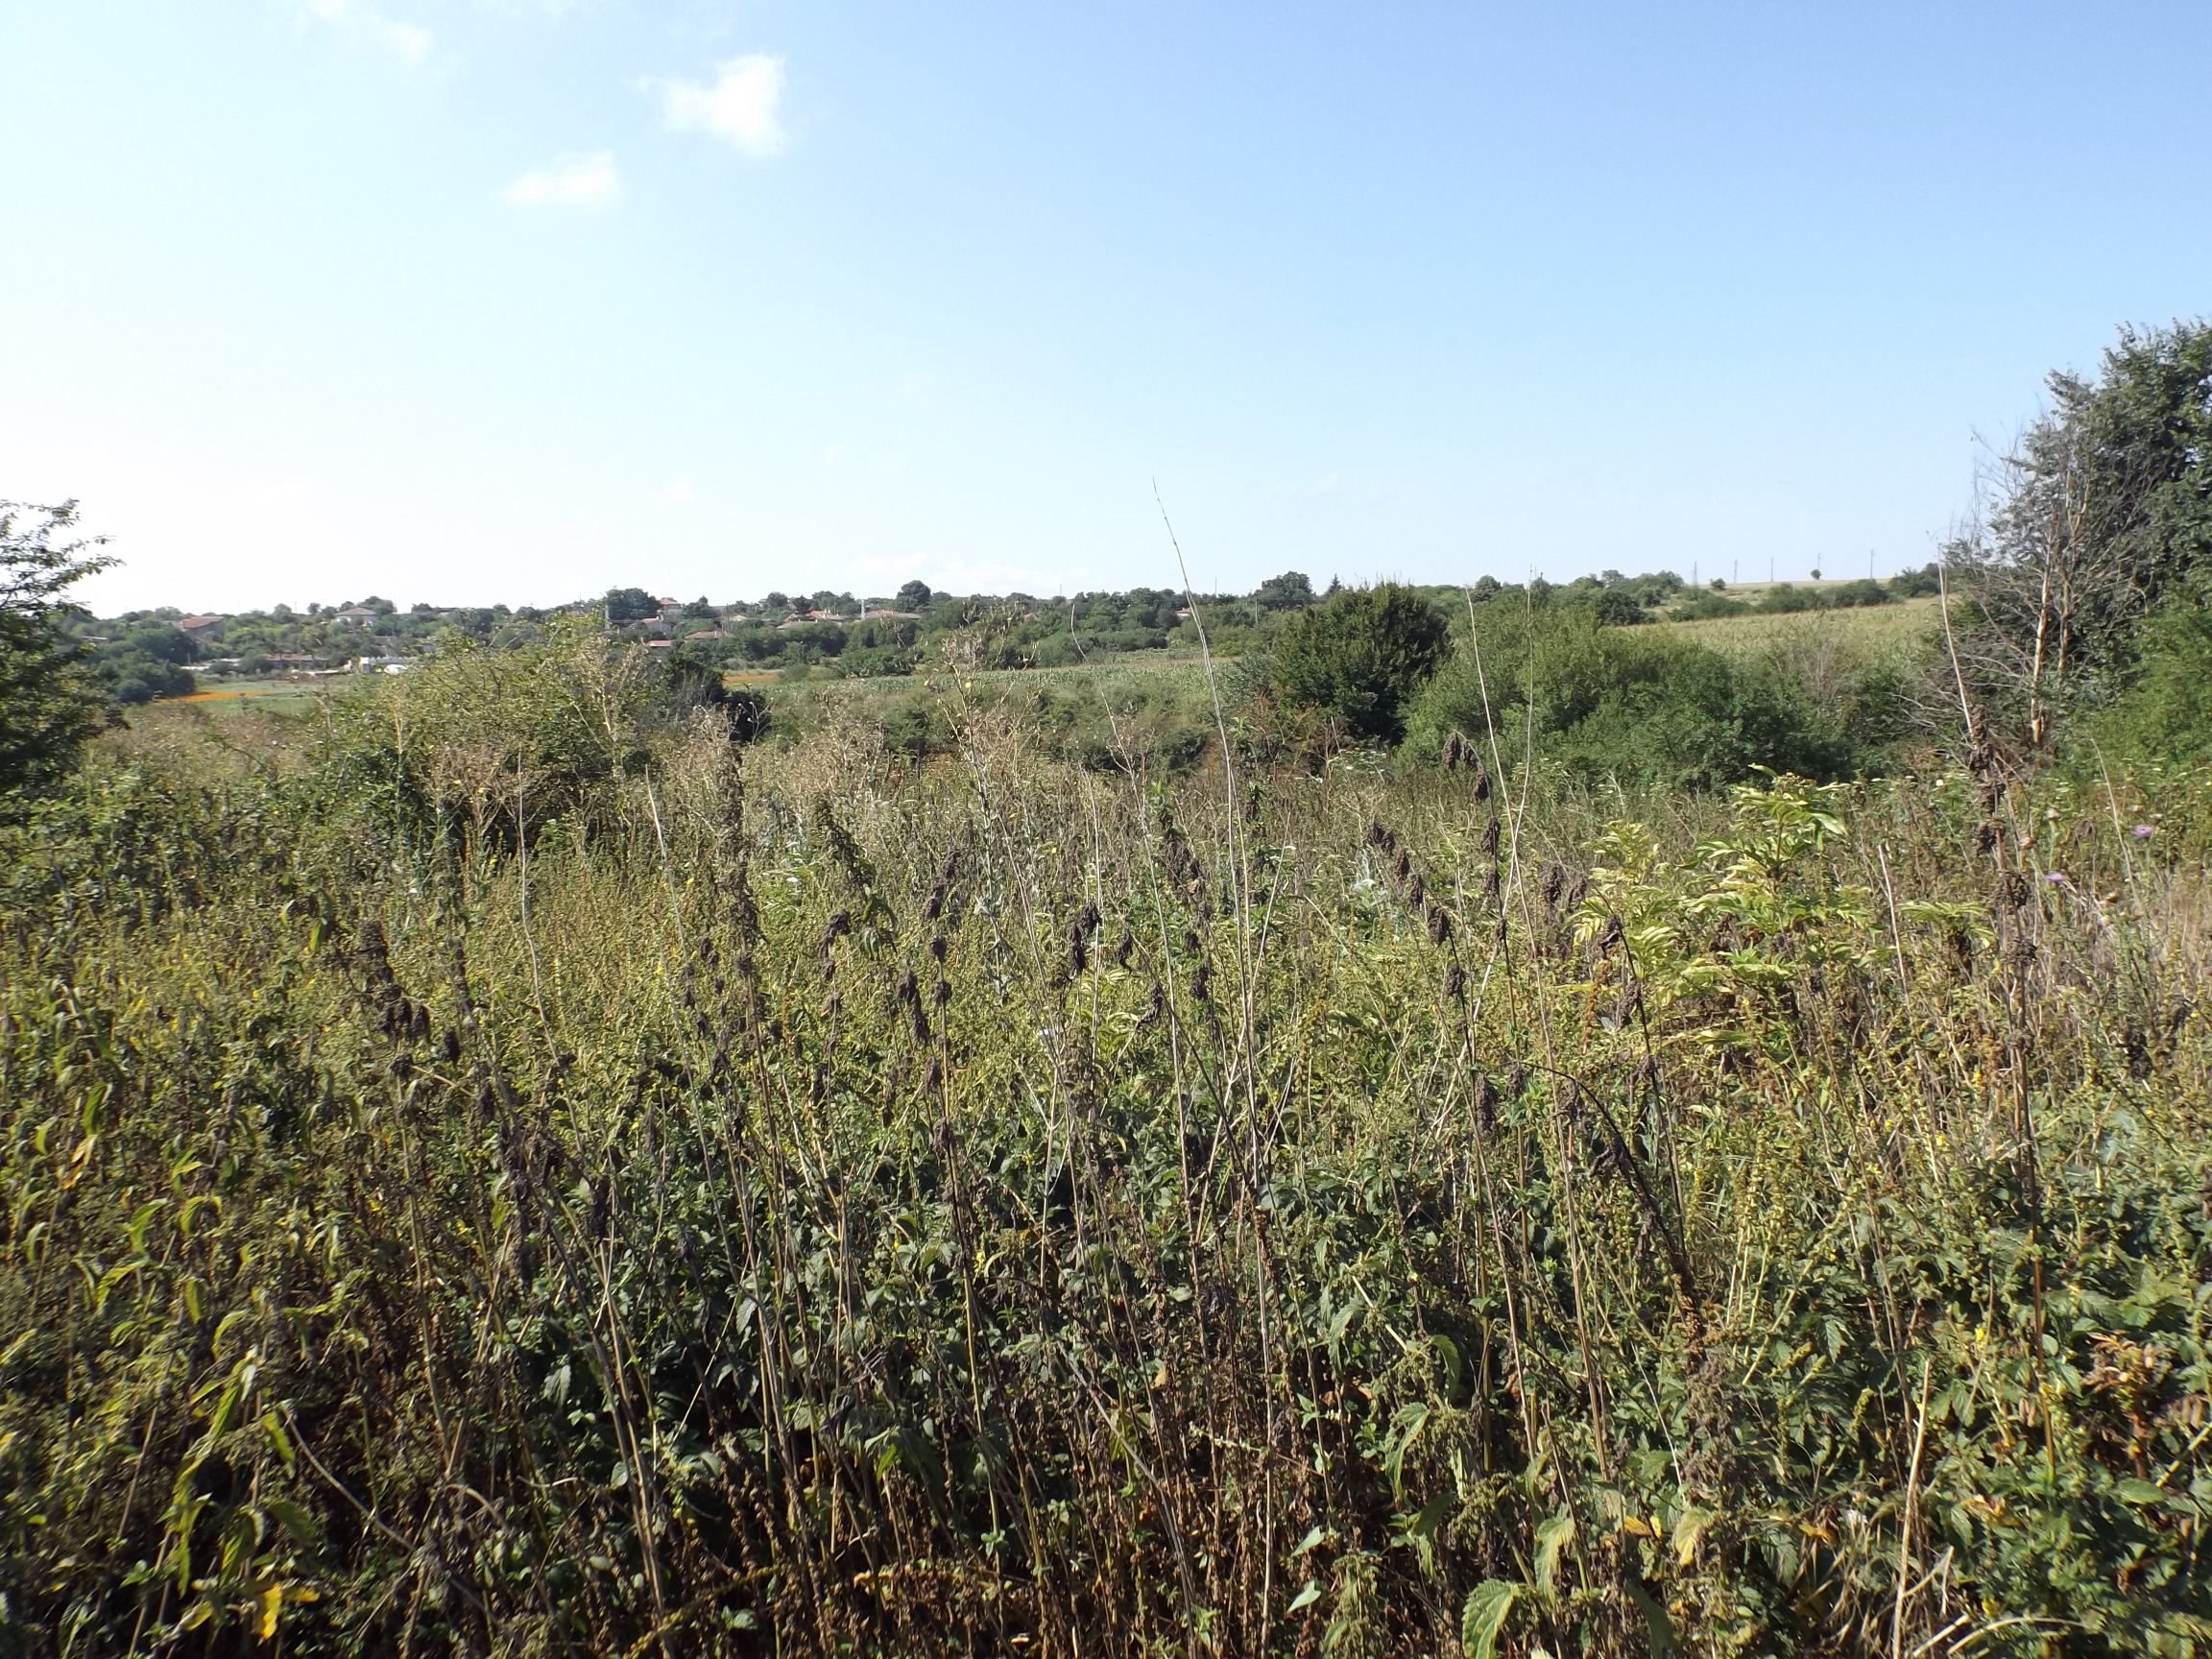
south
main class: Grassland
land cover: Grassland with sparse tree/shrub cover
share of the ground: > 75 %
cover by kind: herbaceous plants 90 %, broadleaved forest trees 5 %, shrubs 5 %
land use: Semi-natural and natural areas not in use
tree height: > 5 m
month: August
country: BG
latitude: 43.3427
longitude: 27.9419
